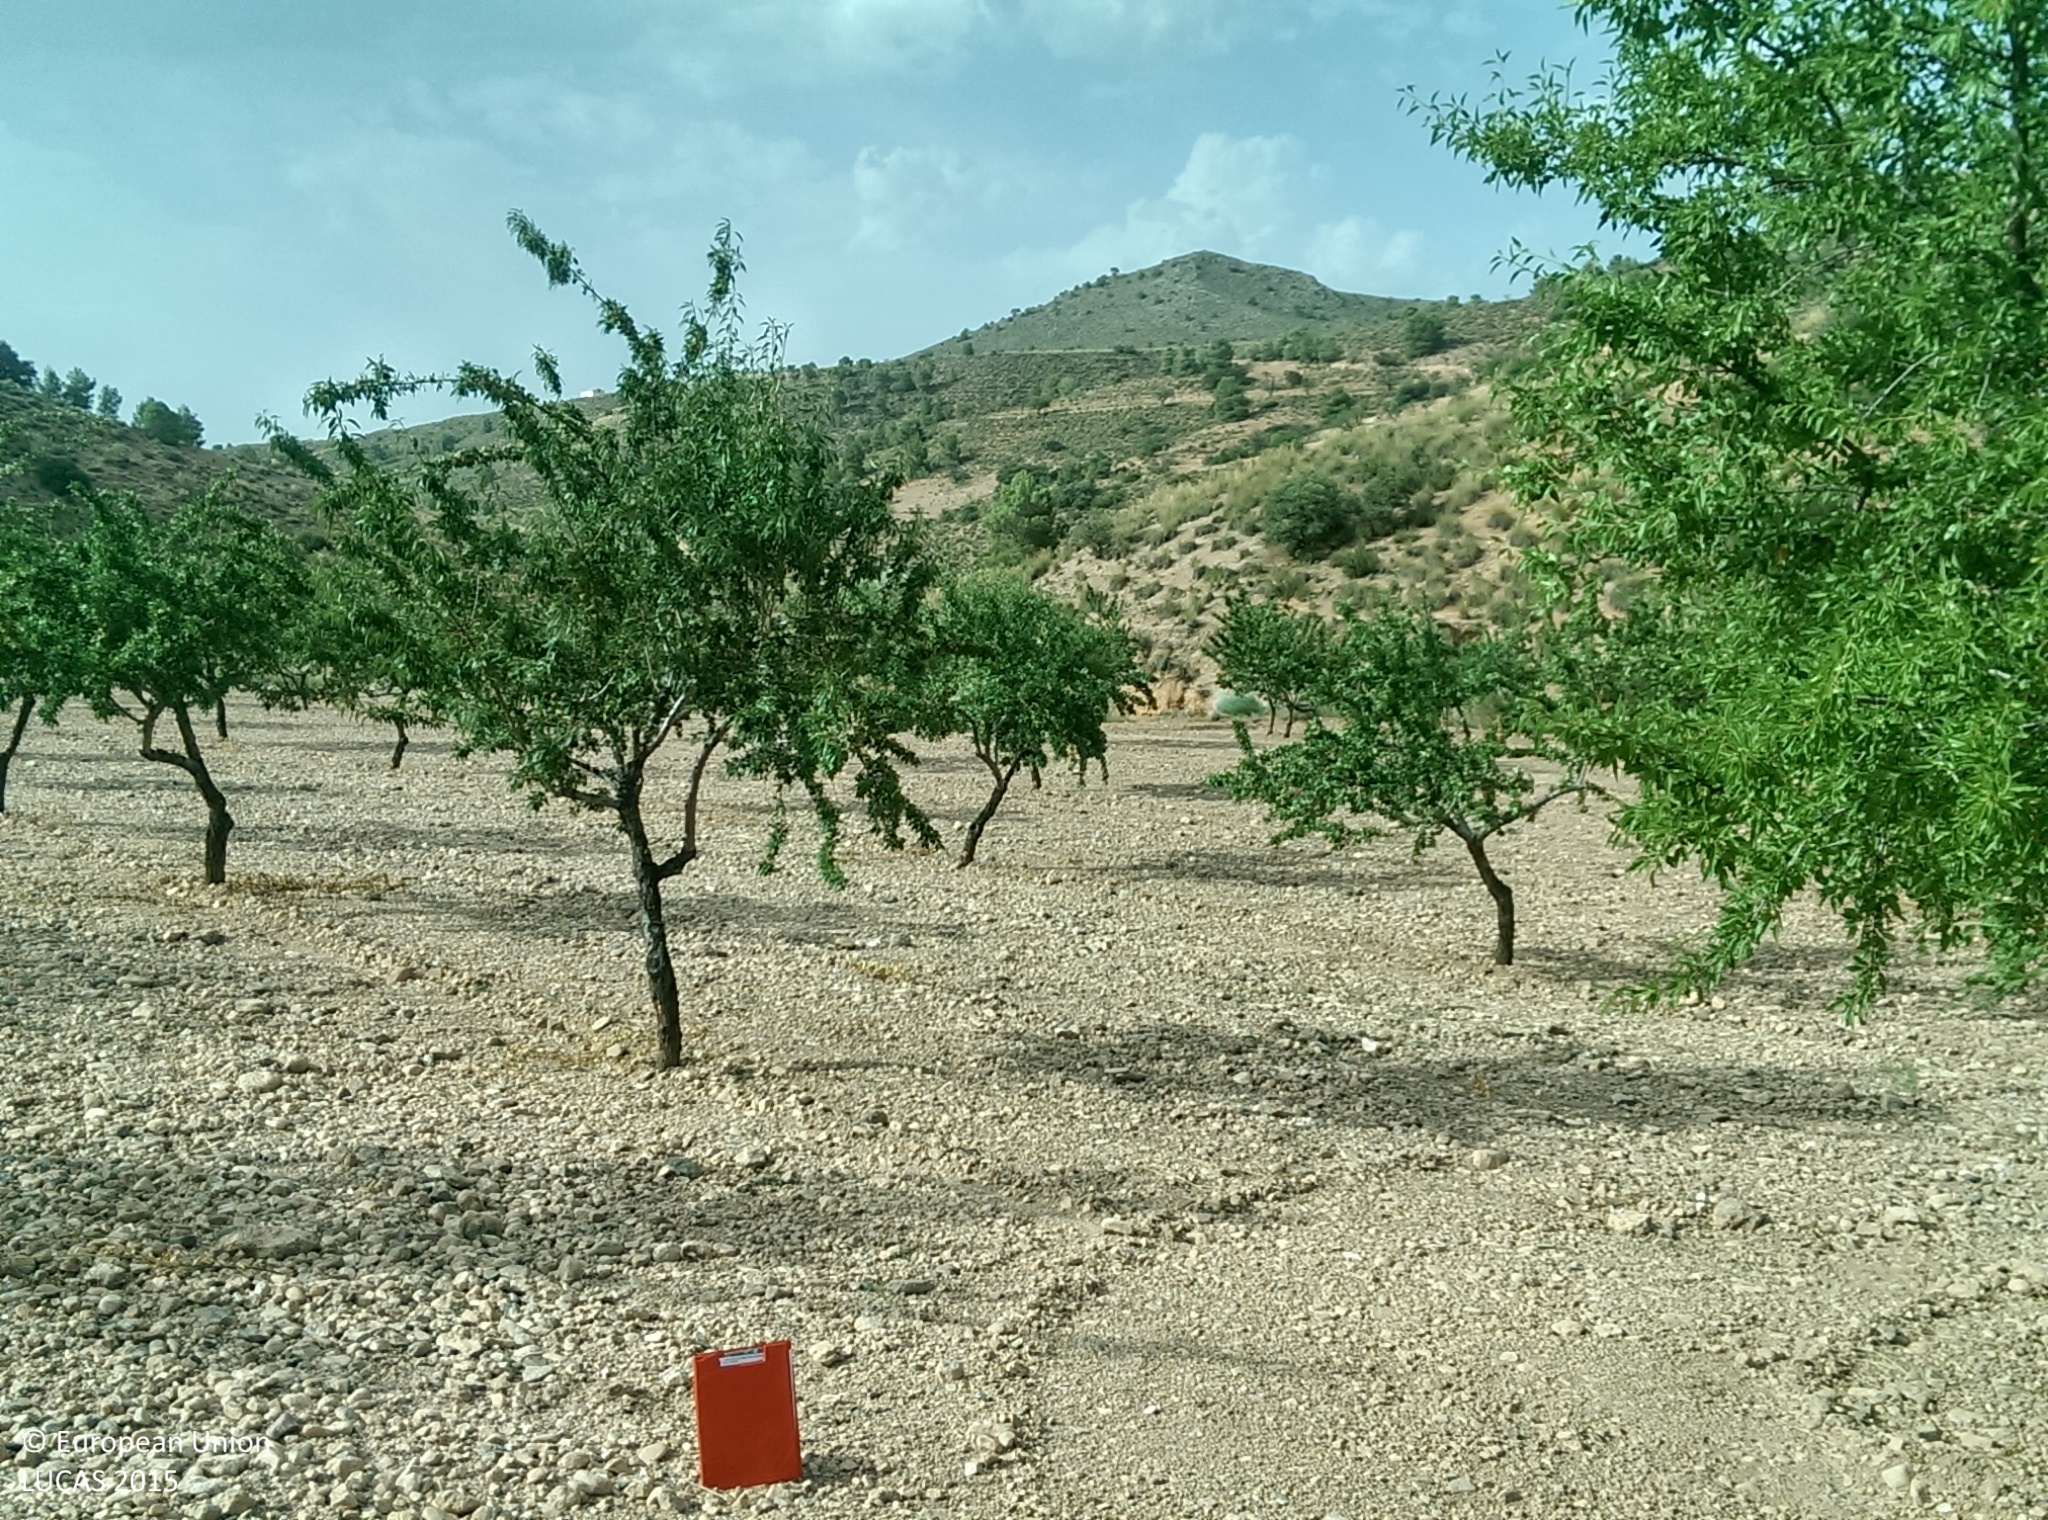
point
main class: Cropland
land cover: Nuts trees
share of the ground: 25 - 50 %
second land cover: Other bare soil
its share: > 75 %
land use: Agriculture (excluding fallow land and kitchen gardens)
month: July
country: ES
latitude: 37.4895
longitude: -2.8926
